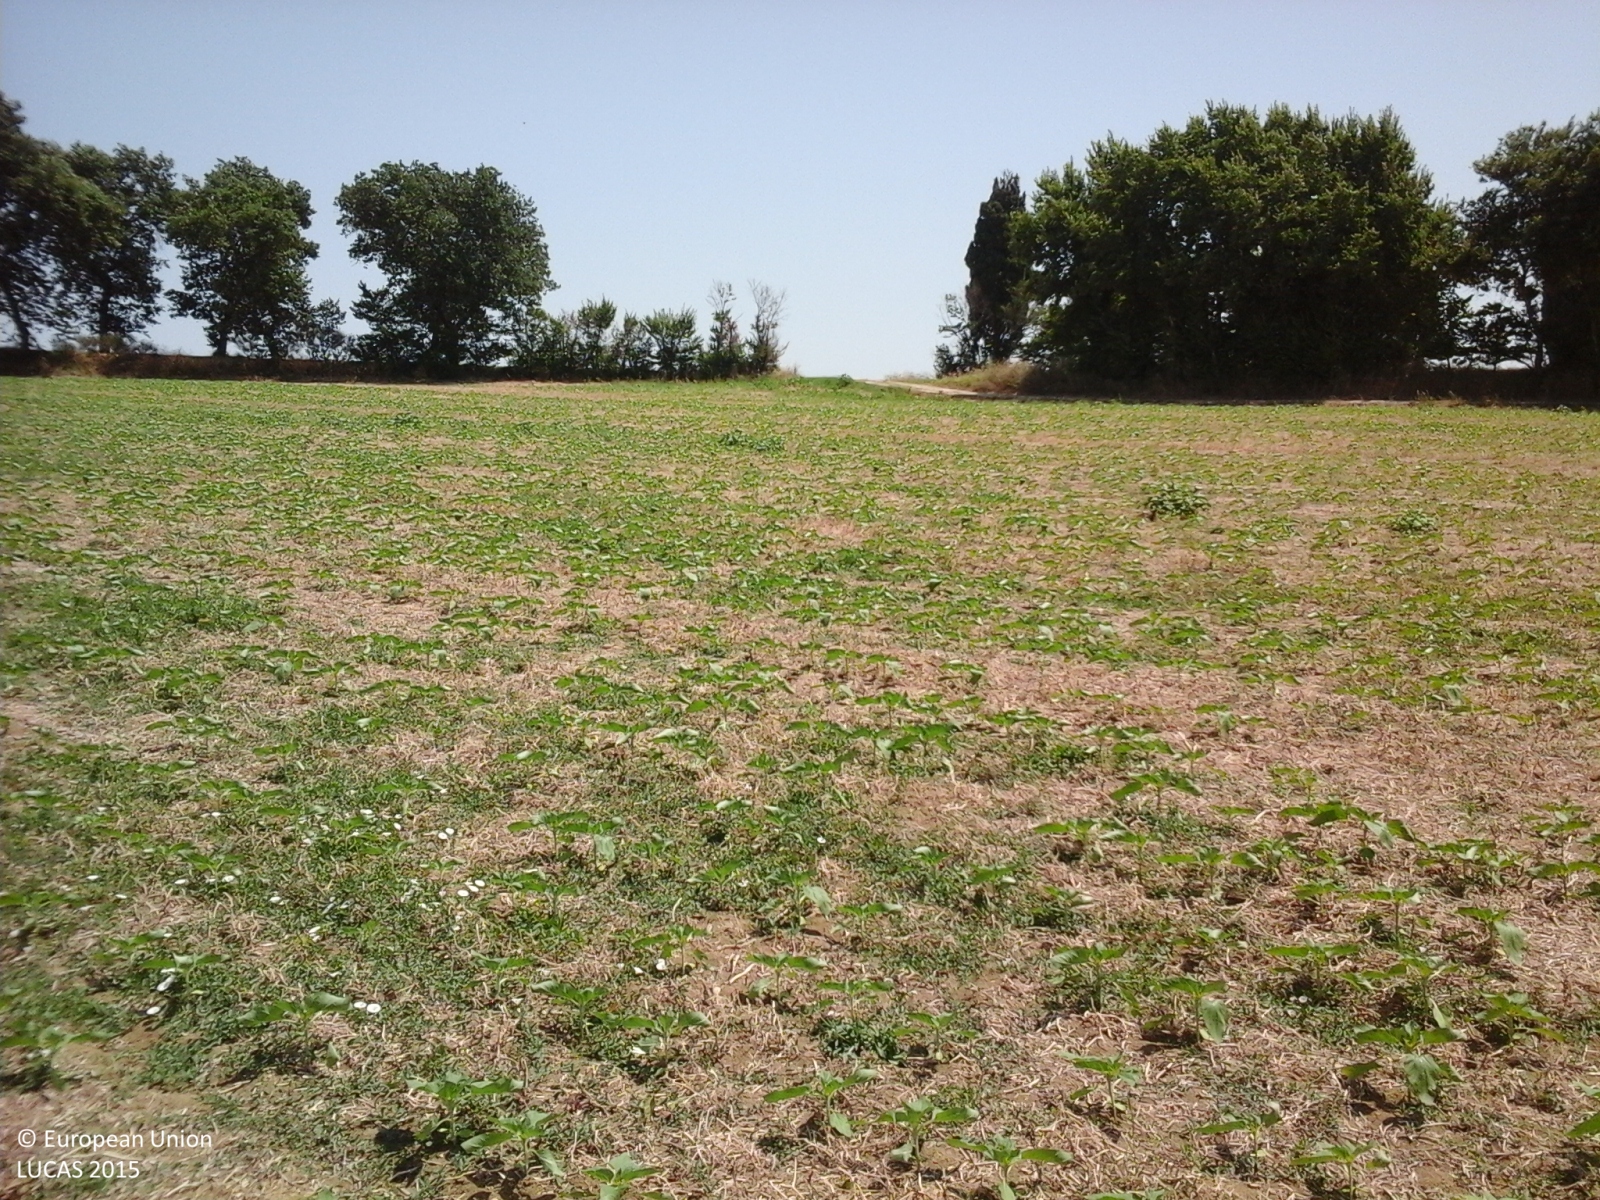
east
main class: Cropland
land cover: Sunflower
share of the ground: 25 - 50 %
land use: Agriculture (excluding fallow land and kitchen gardens)
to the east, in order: Sunflower; Lines of trees; Paved roads, cycling and walking lanes; Lines of trees; Tracks; Durum wheat
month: July
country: IT
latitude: 43.3892
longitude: 13.4849
